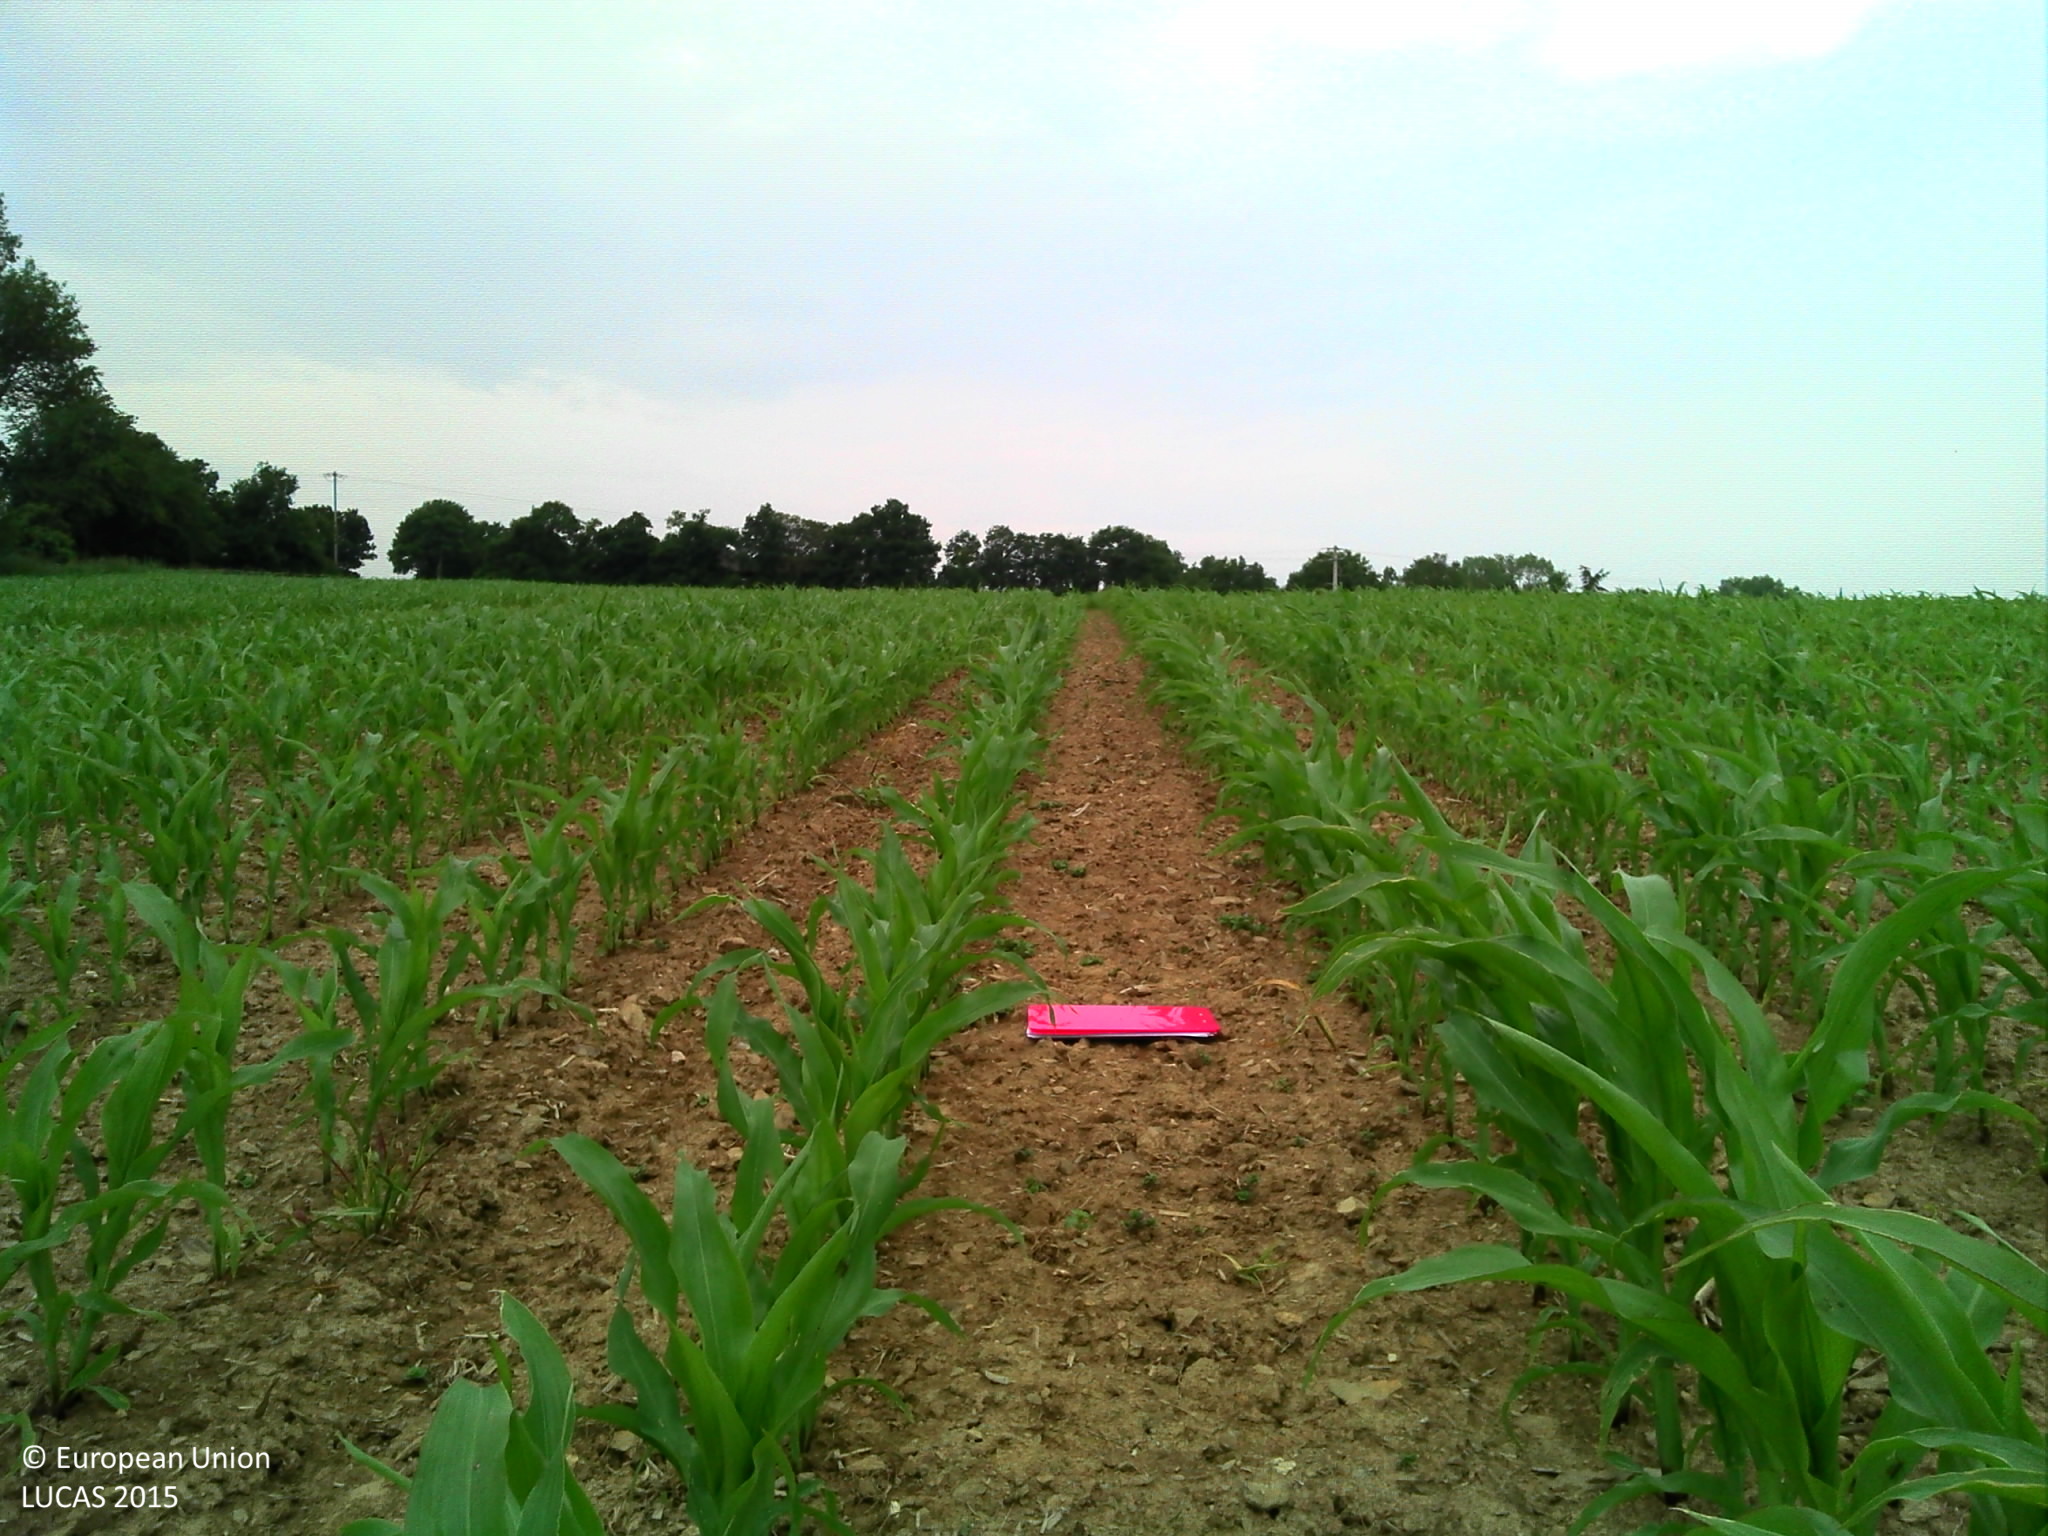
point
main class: Cropland
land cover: Maize
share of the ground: > 75 %
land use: Agriculture (excluding fallow land and kitchen gardens)
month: June
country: FR
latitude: 48.1207
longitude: -2.0770
